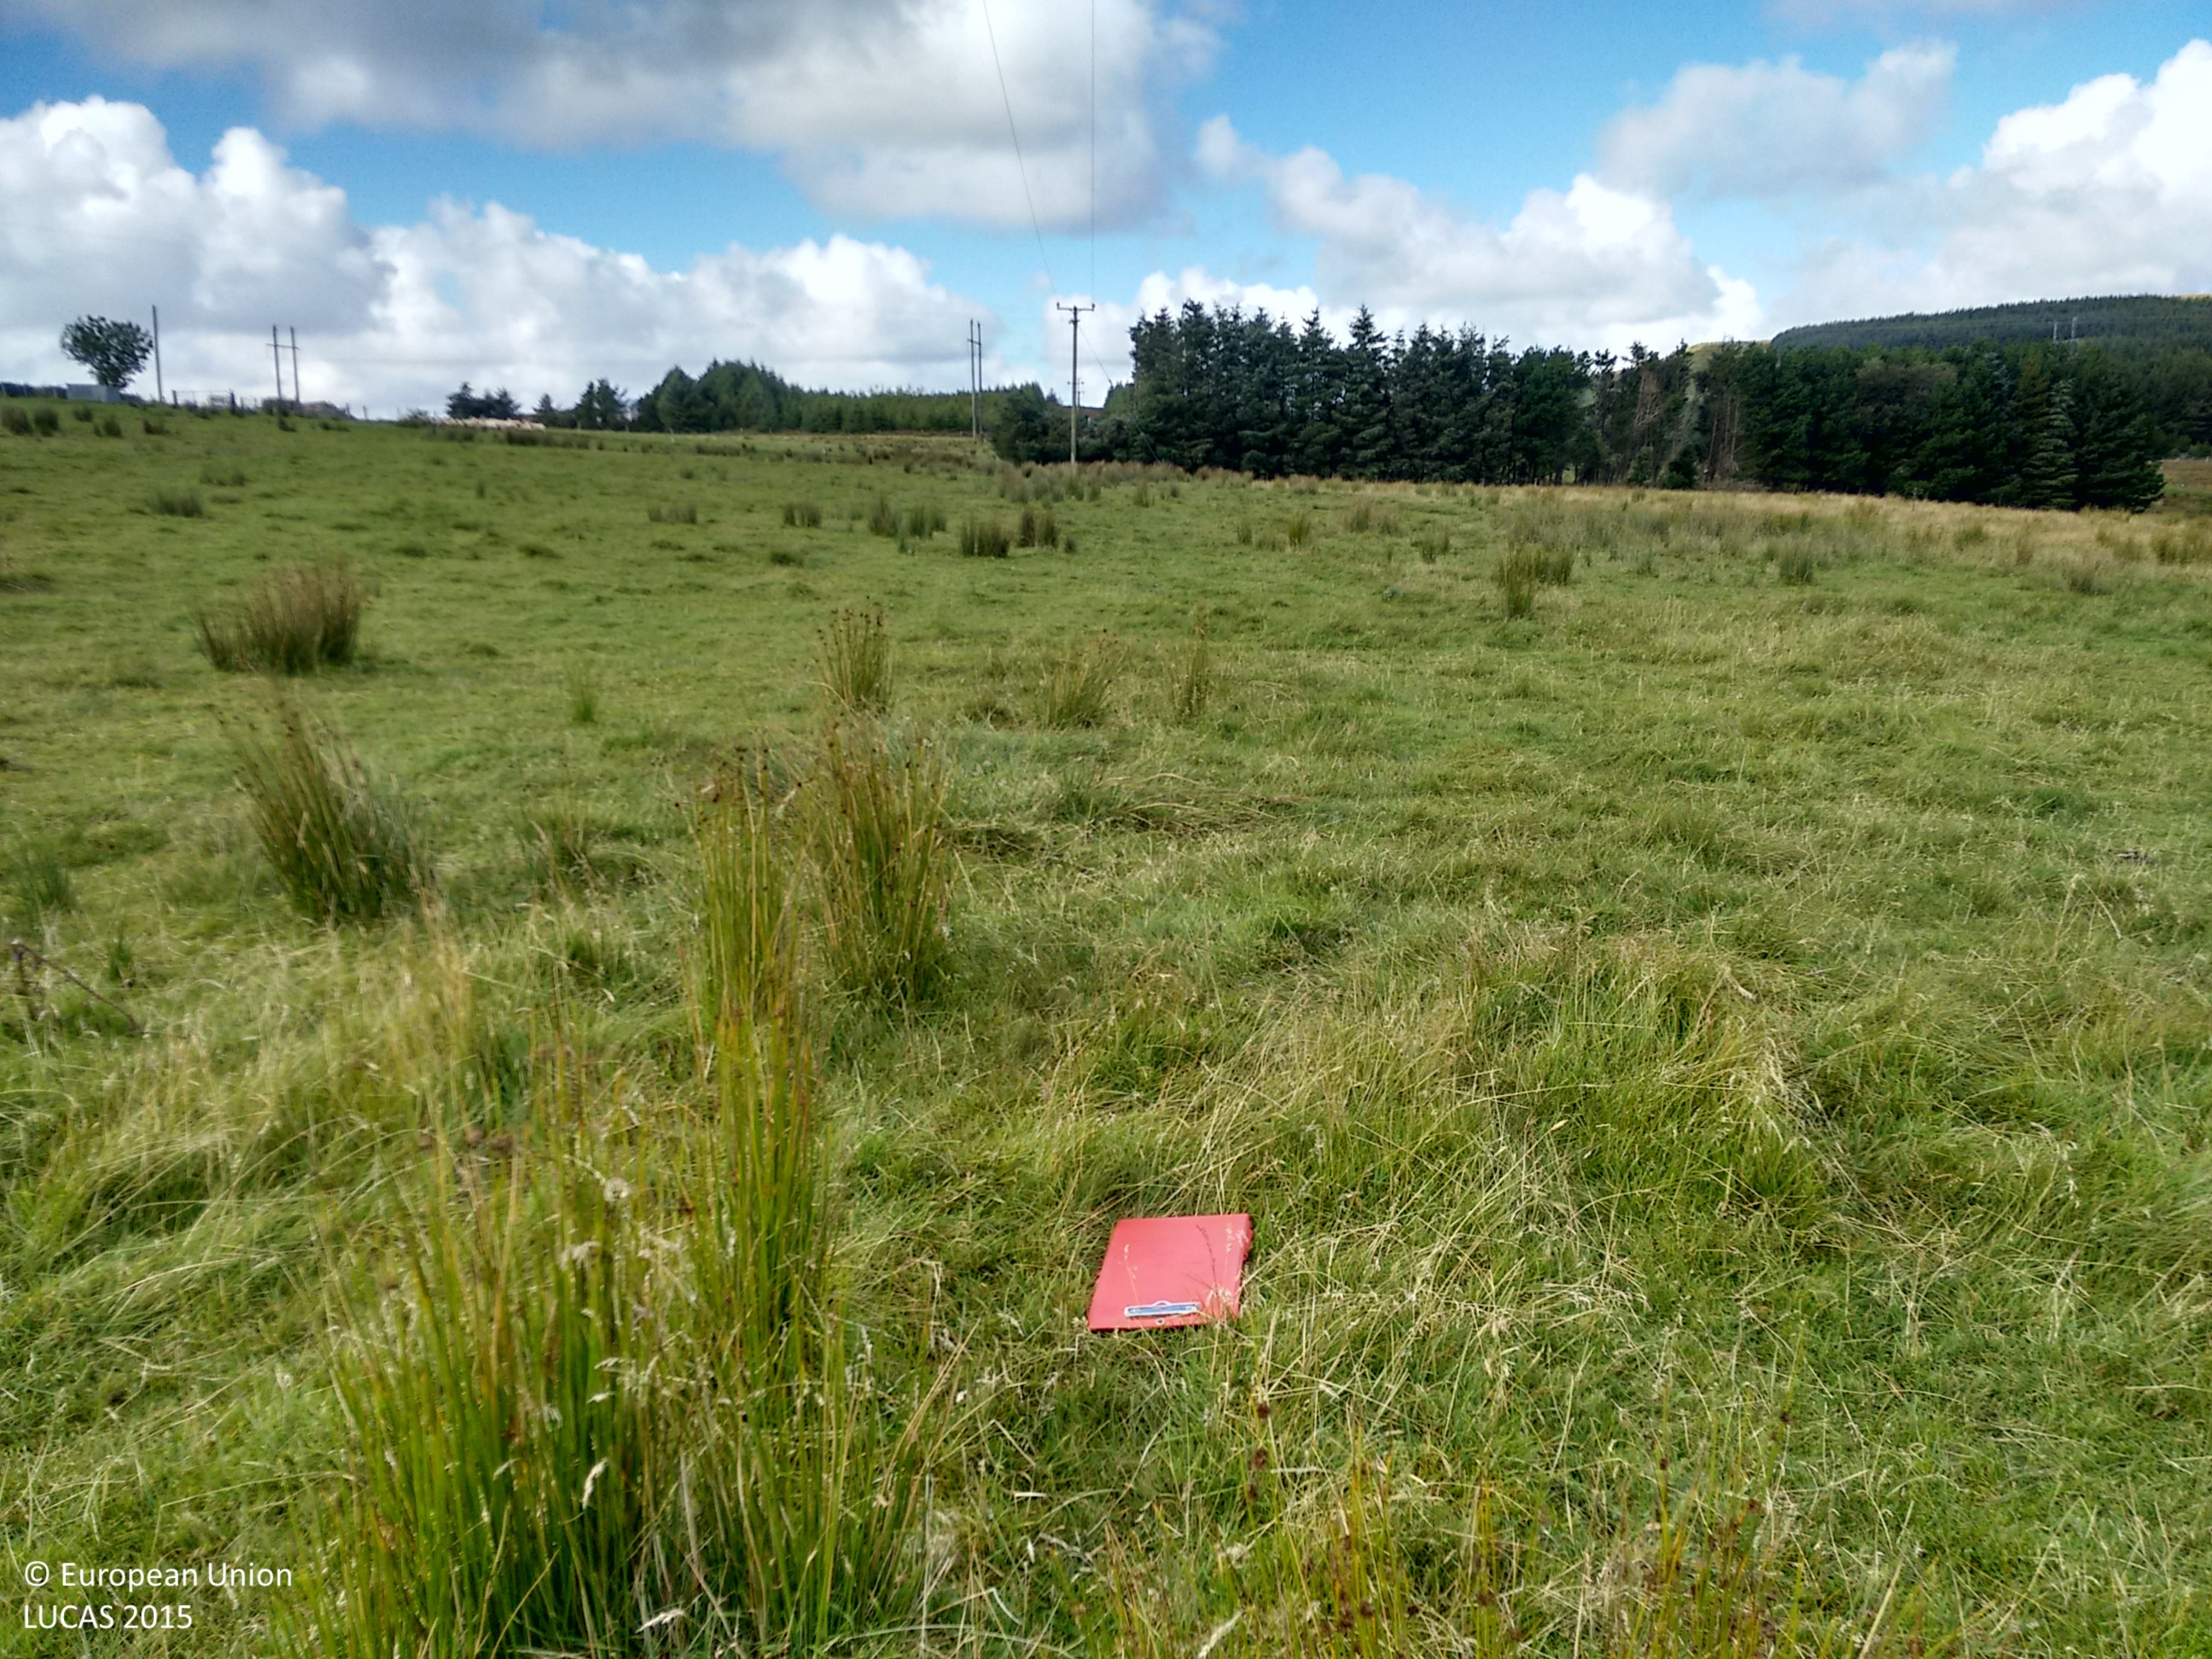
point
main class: Grassland
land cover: Grassland without tree/shrub cover
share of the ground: > 75 %
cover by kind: herbaceous plants 100 %
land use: Agriculture (excluding fallow land and kitchen gardens)
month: September
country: IE
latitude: 55.1165
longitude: -7.3803
